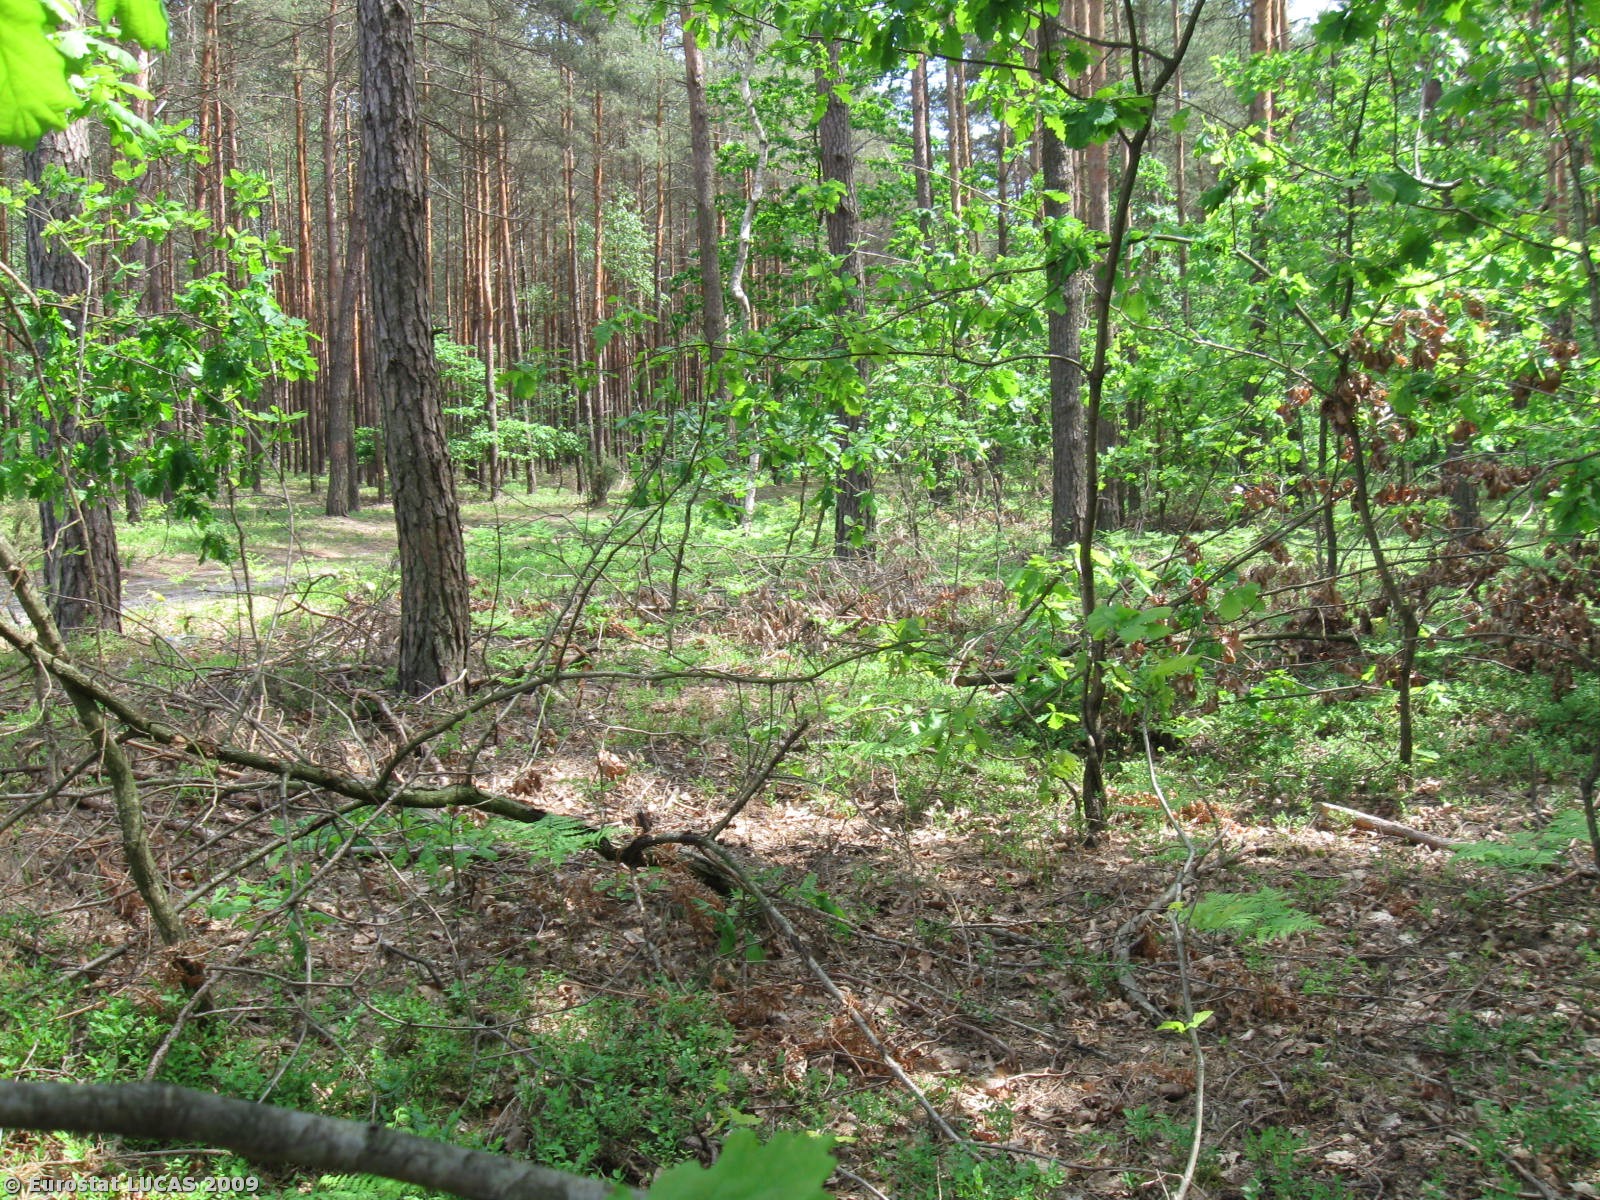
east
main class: Woodland
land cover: Coniferous woodland
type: hemiboreal forest and nemoral coniferous forest and mixed broadleaved-coniferous forest
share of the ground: > 75 %
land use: Forestry
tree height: > 5 m
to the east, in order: Coniferous woodland; Paved roads, cycling and walking lanes; Coniferous woodland; Electric lines; Broadleaved woodland
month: May
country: PL
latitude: 50.6905
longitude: 20.3559
